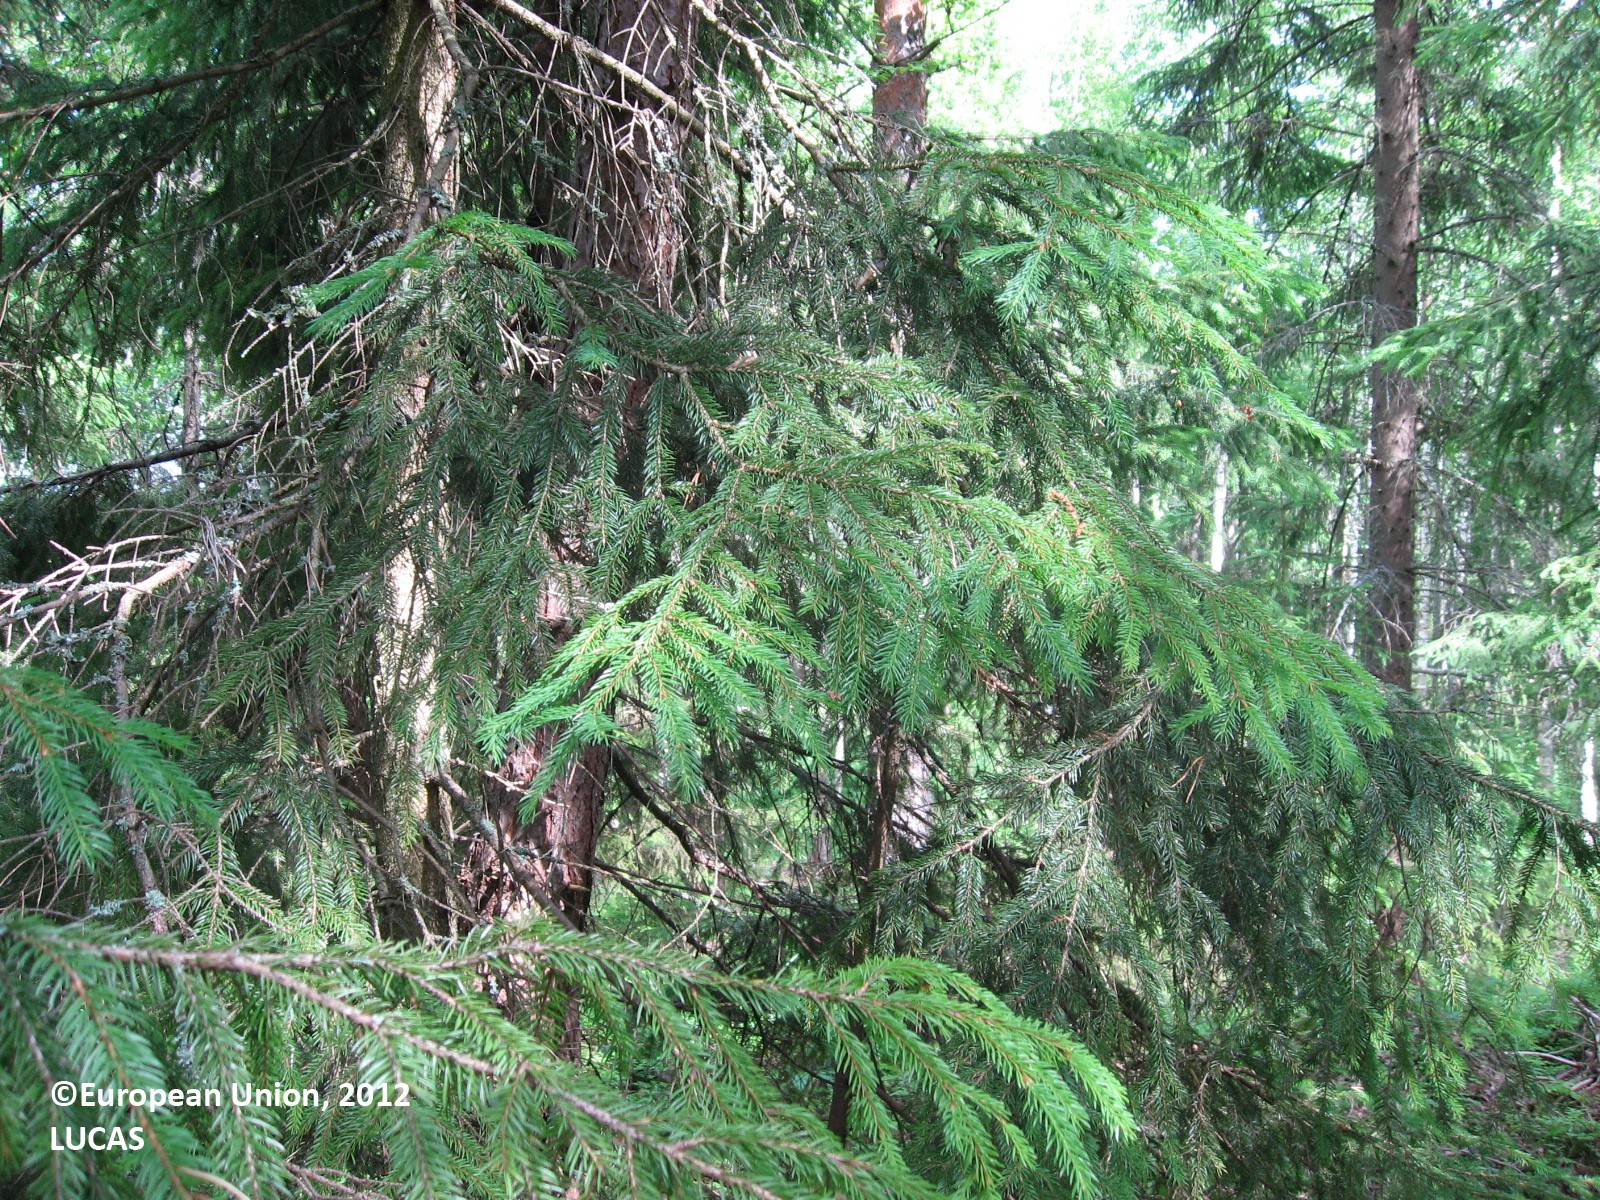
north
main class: Woodland
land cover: Other mixed woodland
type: boreal forest
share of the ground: > 75 %
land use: Forestry
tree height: > 5 m
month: June
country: FI
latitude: 60.5407
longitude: 26.5443
